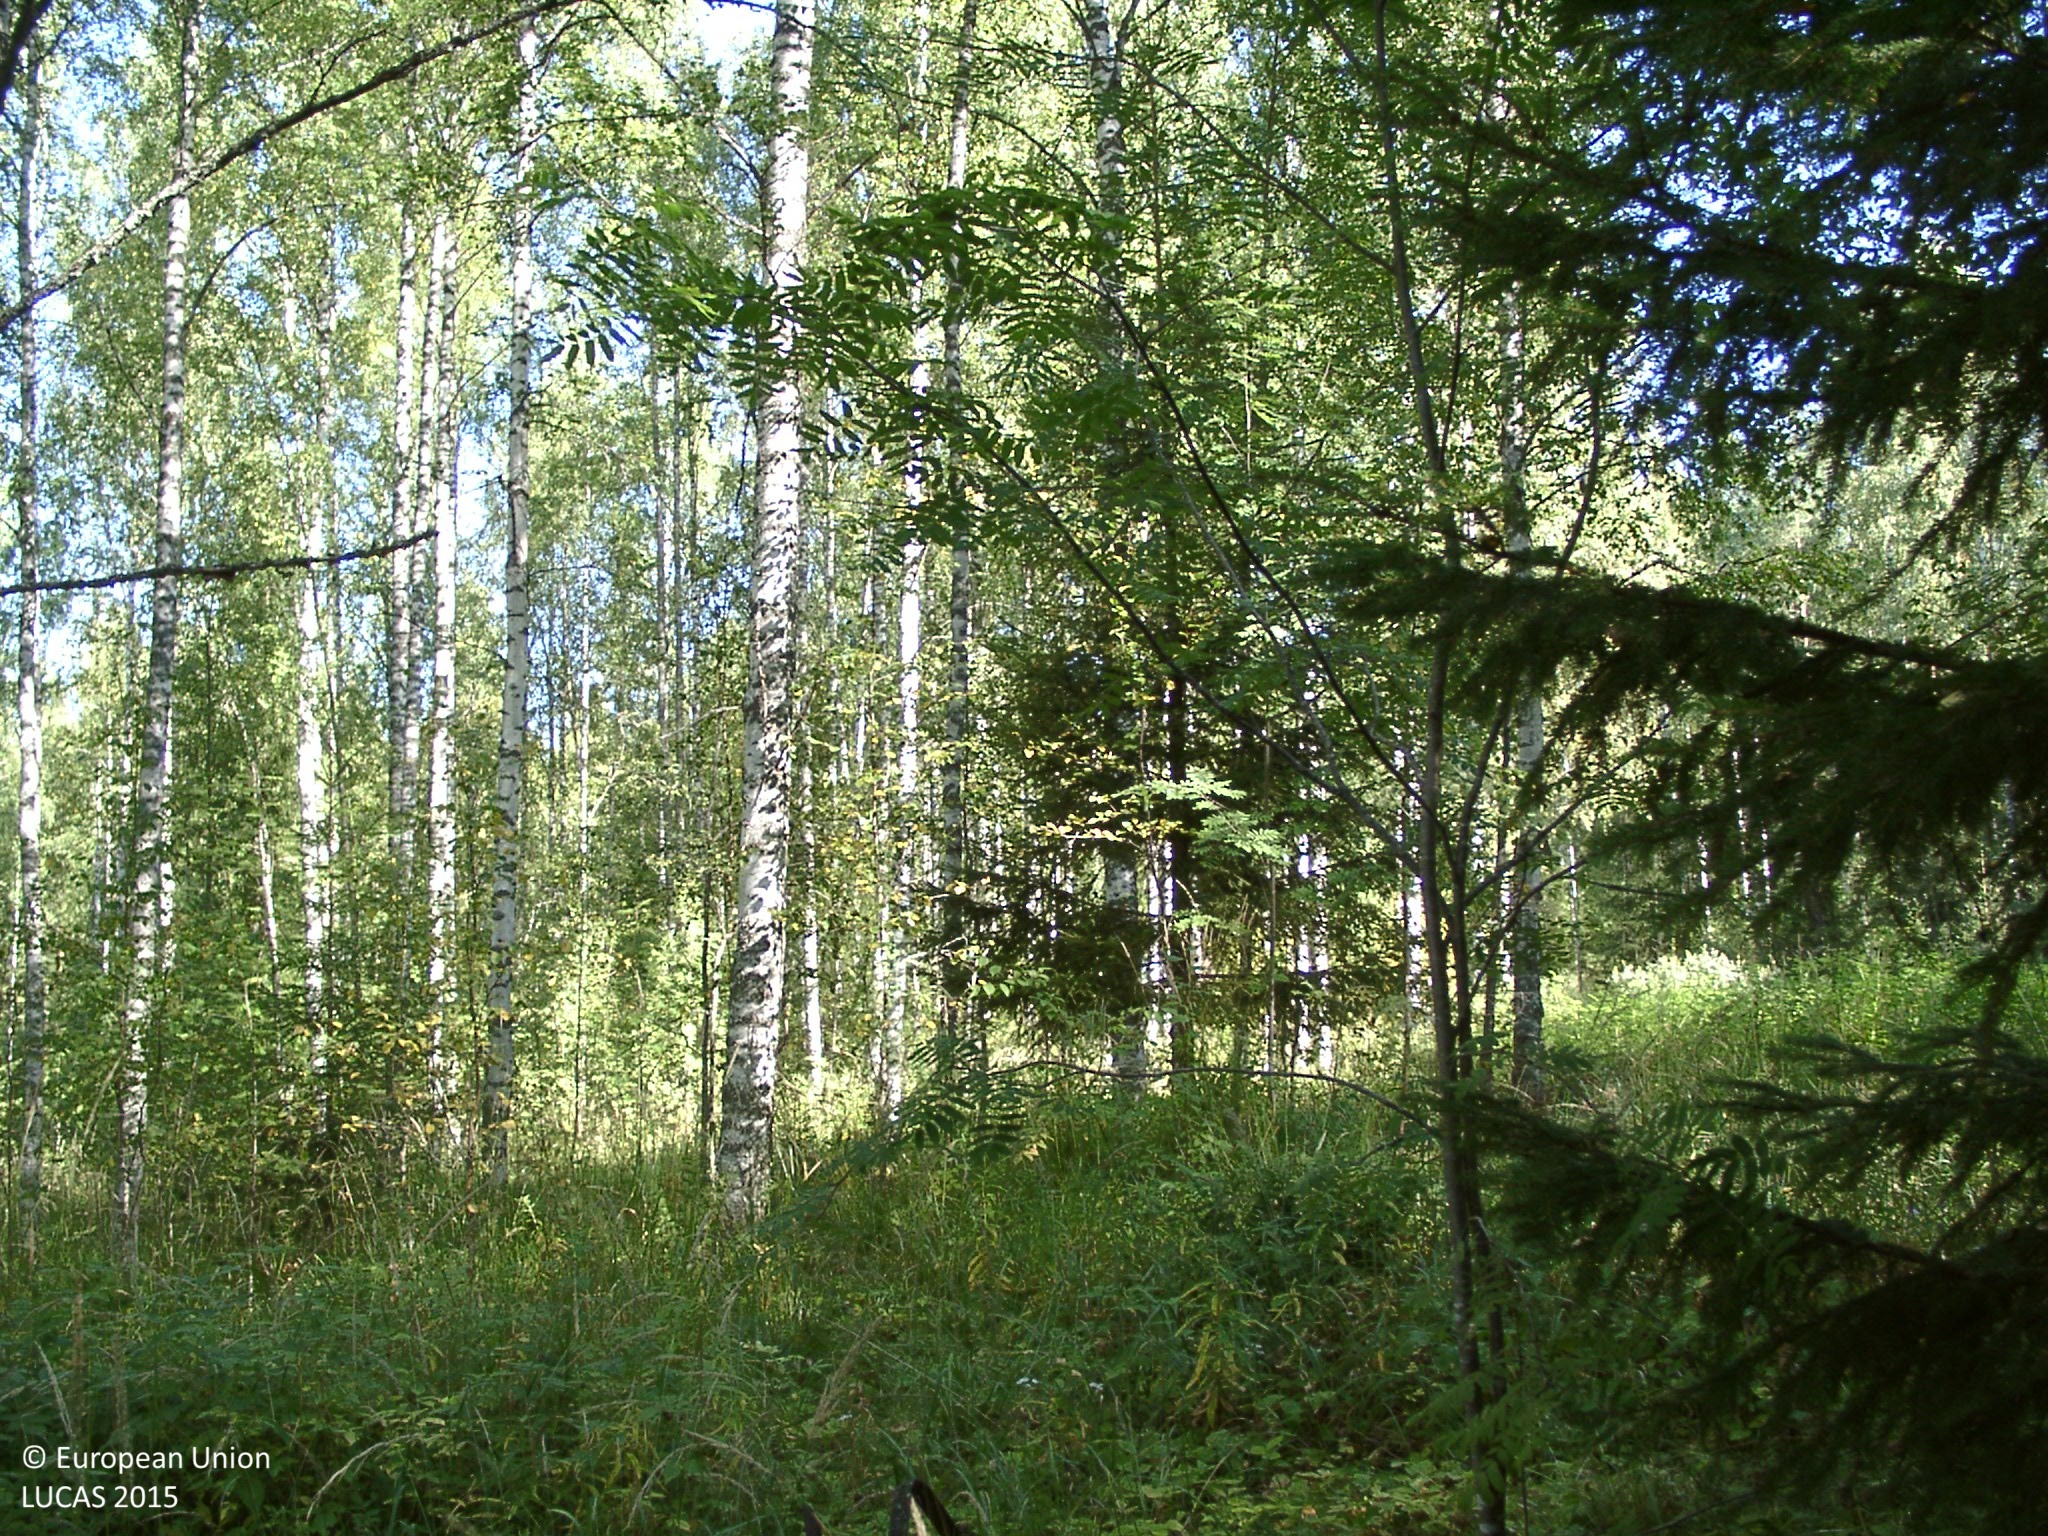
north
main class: Woodland
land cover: Broadleaved woodland
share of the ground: 50 - 75 %
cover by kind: broadleaved forest trees 55 %, herbaceous plants 30 %, coniferous forest trees 15 %
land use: Forestry
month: August
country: FI
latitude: 61.9613
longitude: 25.0376
